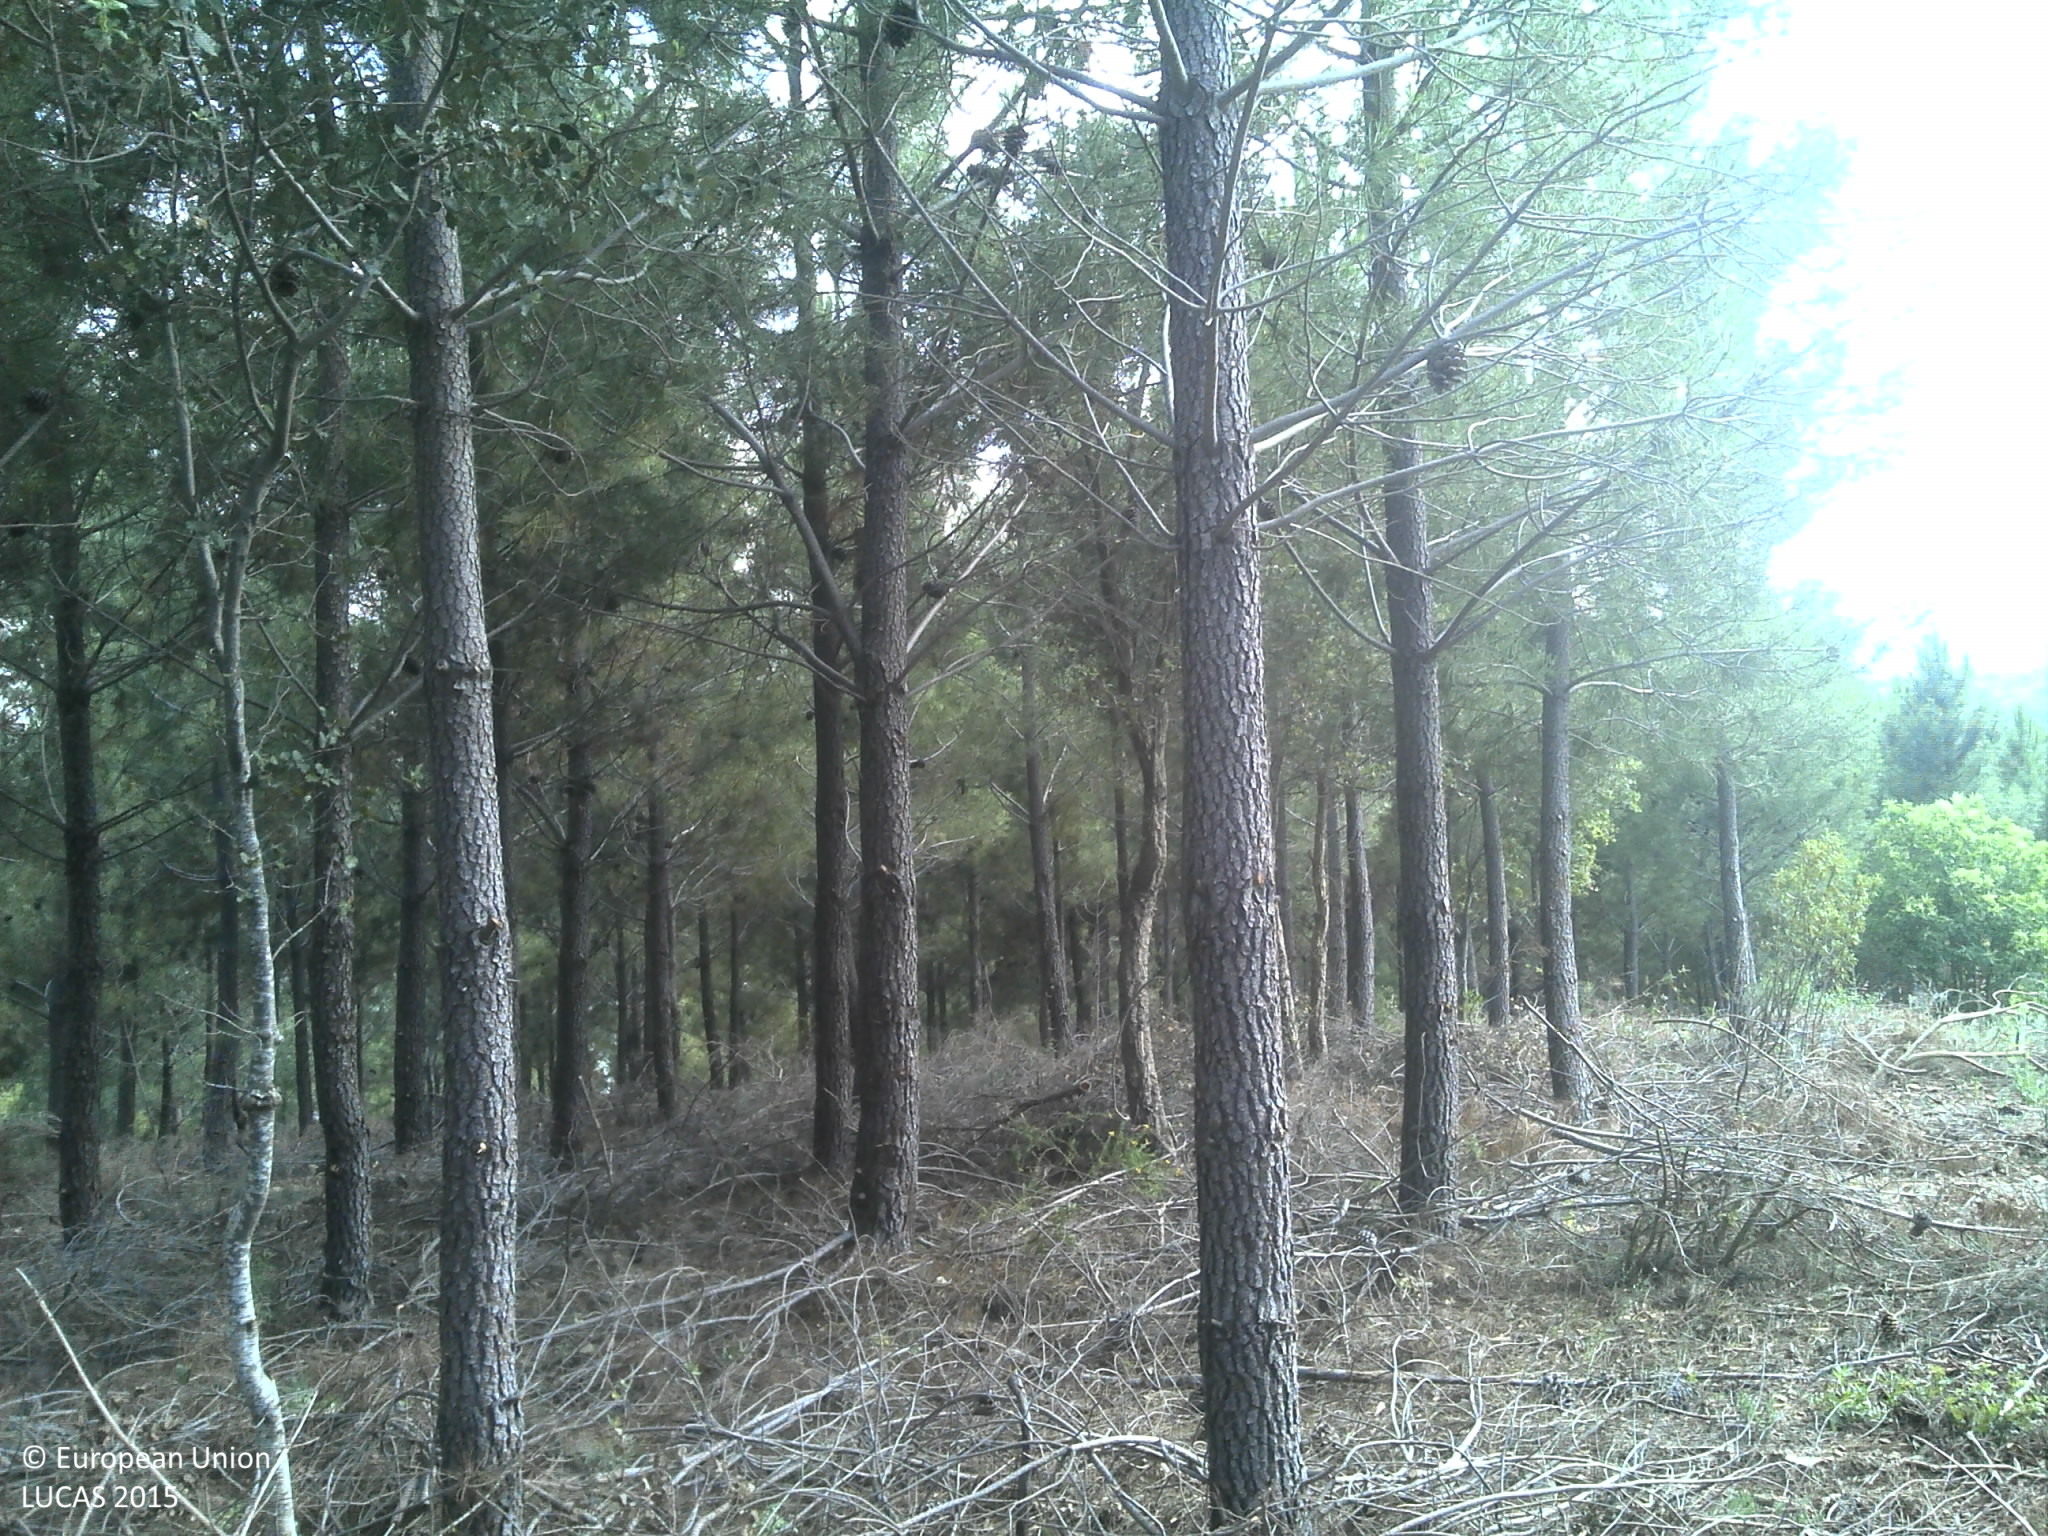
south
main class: Shrubland
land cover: Shrubland with sparse tree cover
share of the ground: 50 - 75 %
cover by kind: shrubs 75 %, unconsolidated bare surface 10 %, coniferous forest trees 5 %
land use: Forestry
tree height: > 5 m
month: June
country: PT
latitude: 40.2770
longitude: -7.1400
